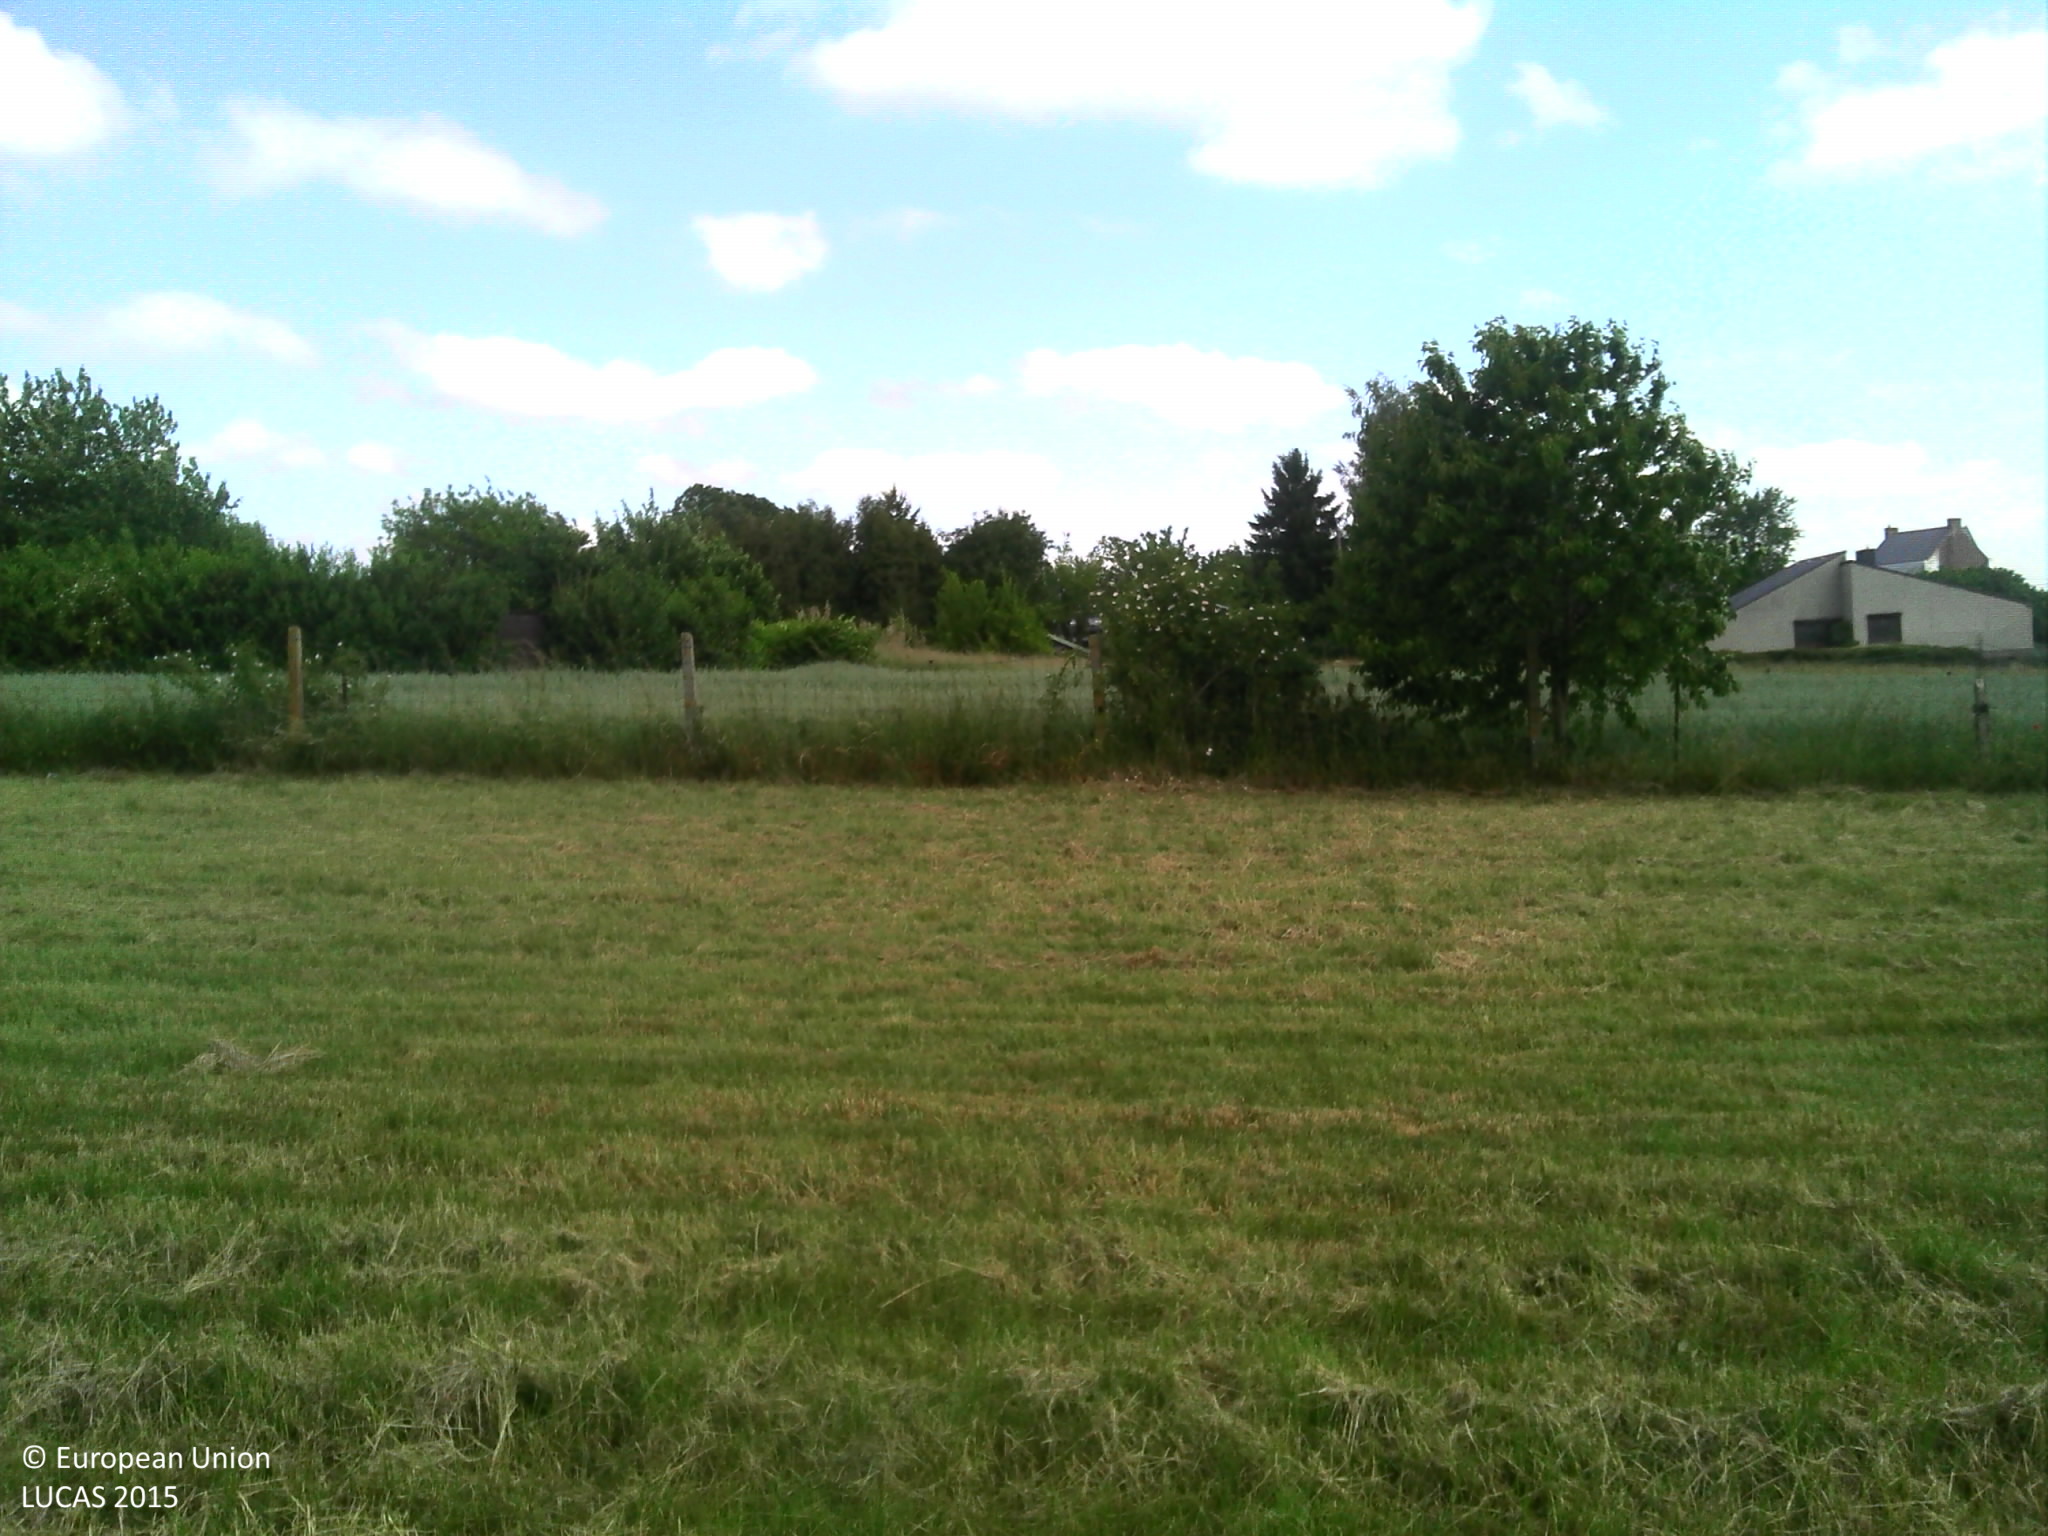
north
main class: Grassland
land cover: Grassland without tree/shrub cover
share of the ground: > 75 %
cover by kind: herbaceous plants 100 %
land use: Residential
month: June
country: BE
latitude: 50.4363
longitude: 4.6320
